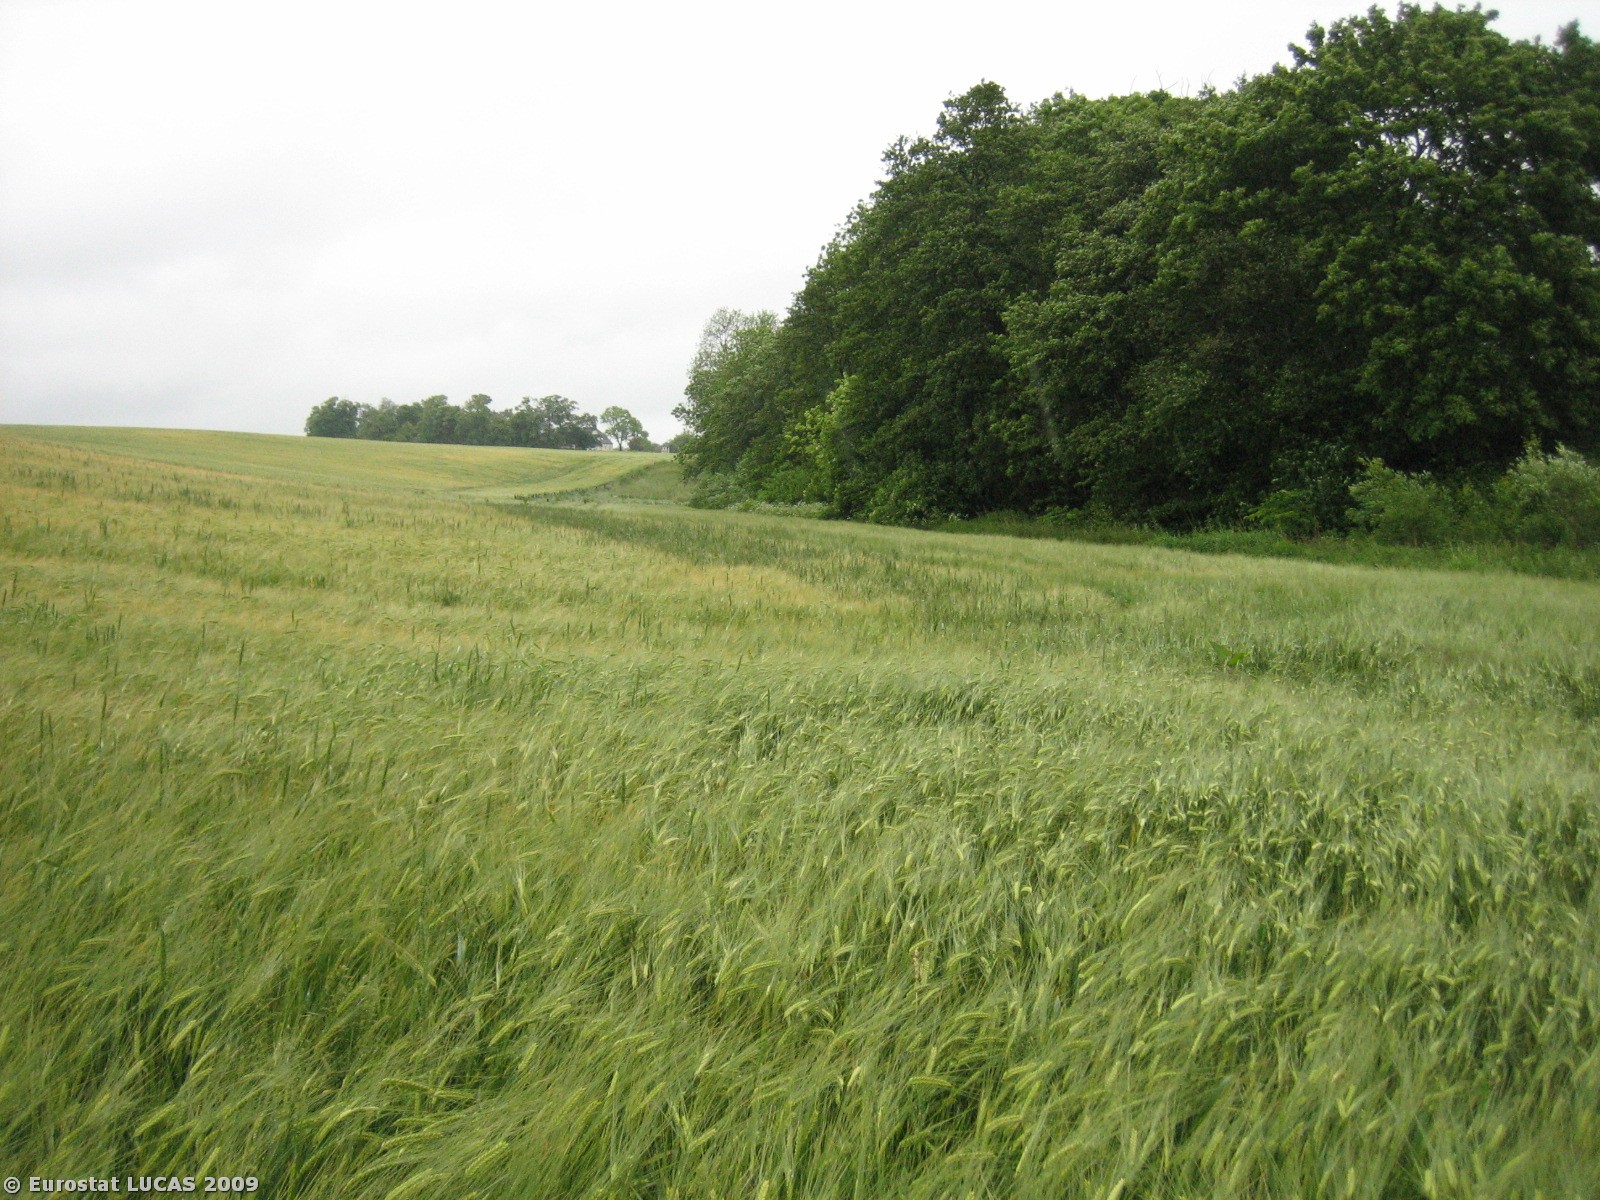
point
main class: Cropland
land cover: Barley
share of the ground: > 75 %
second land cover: Common wheat
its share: < 10 %
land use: Agriculture (excluding fallow land and kitchen gardens)
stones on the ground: < 10 %
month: June
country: DK
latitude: 55.9900
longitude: 10.0160
